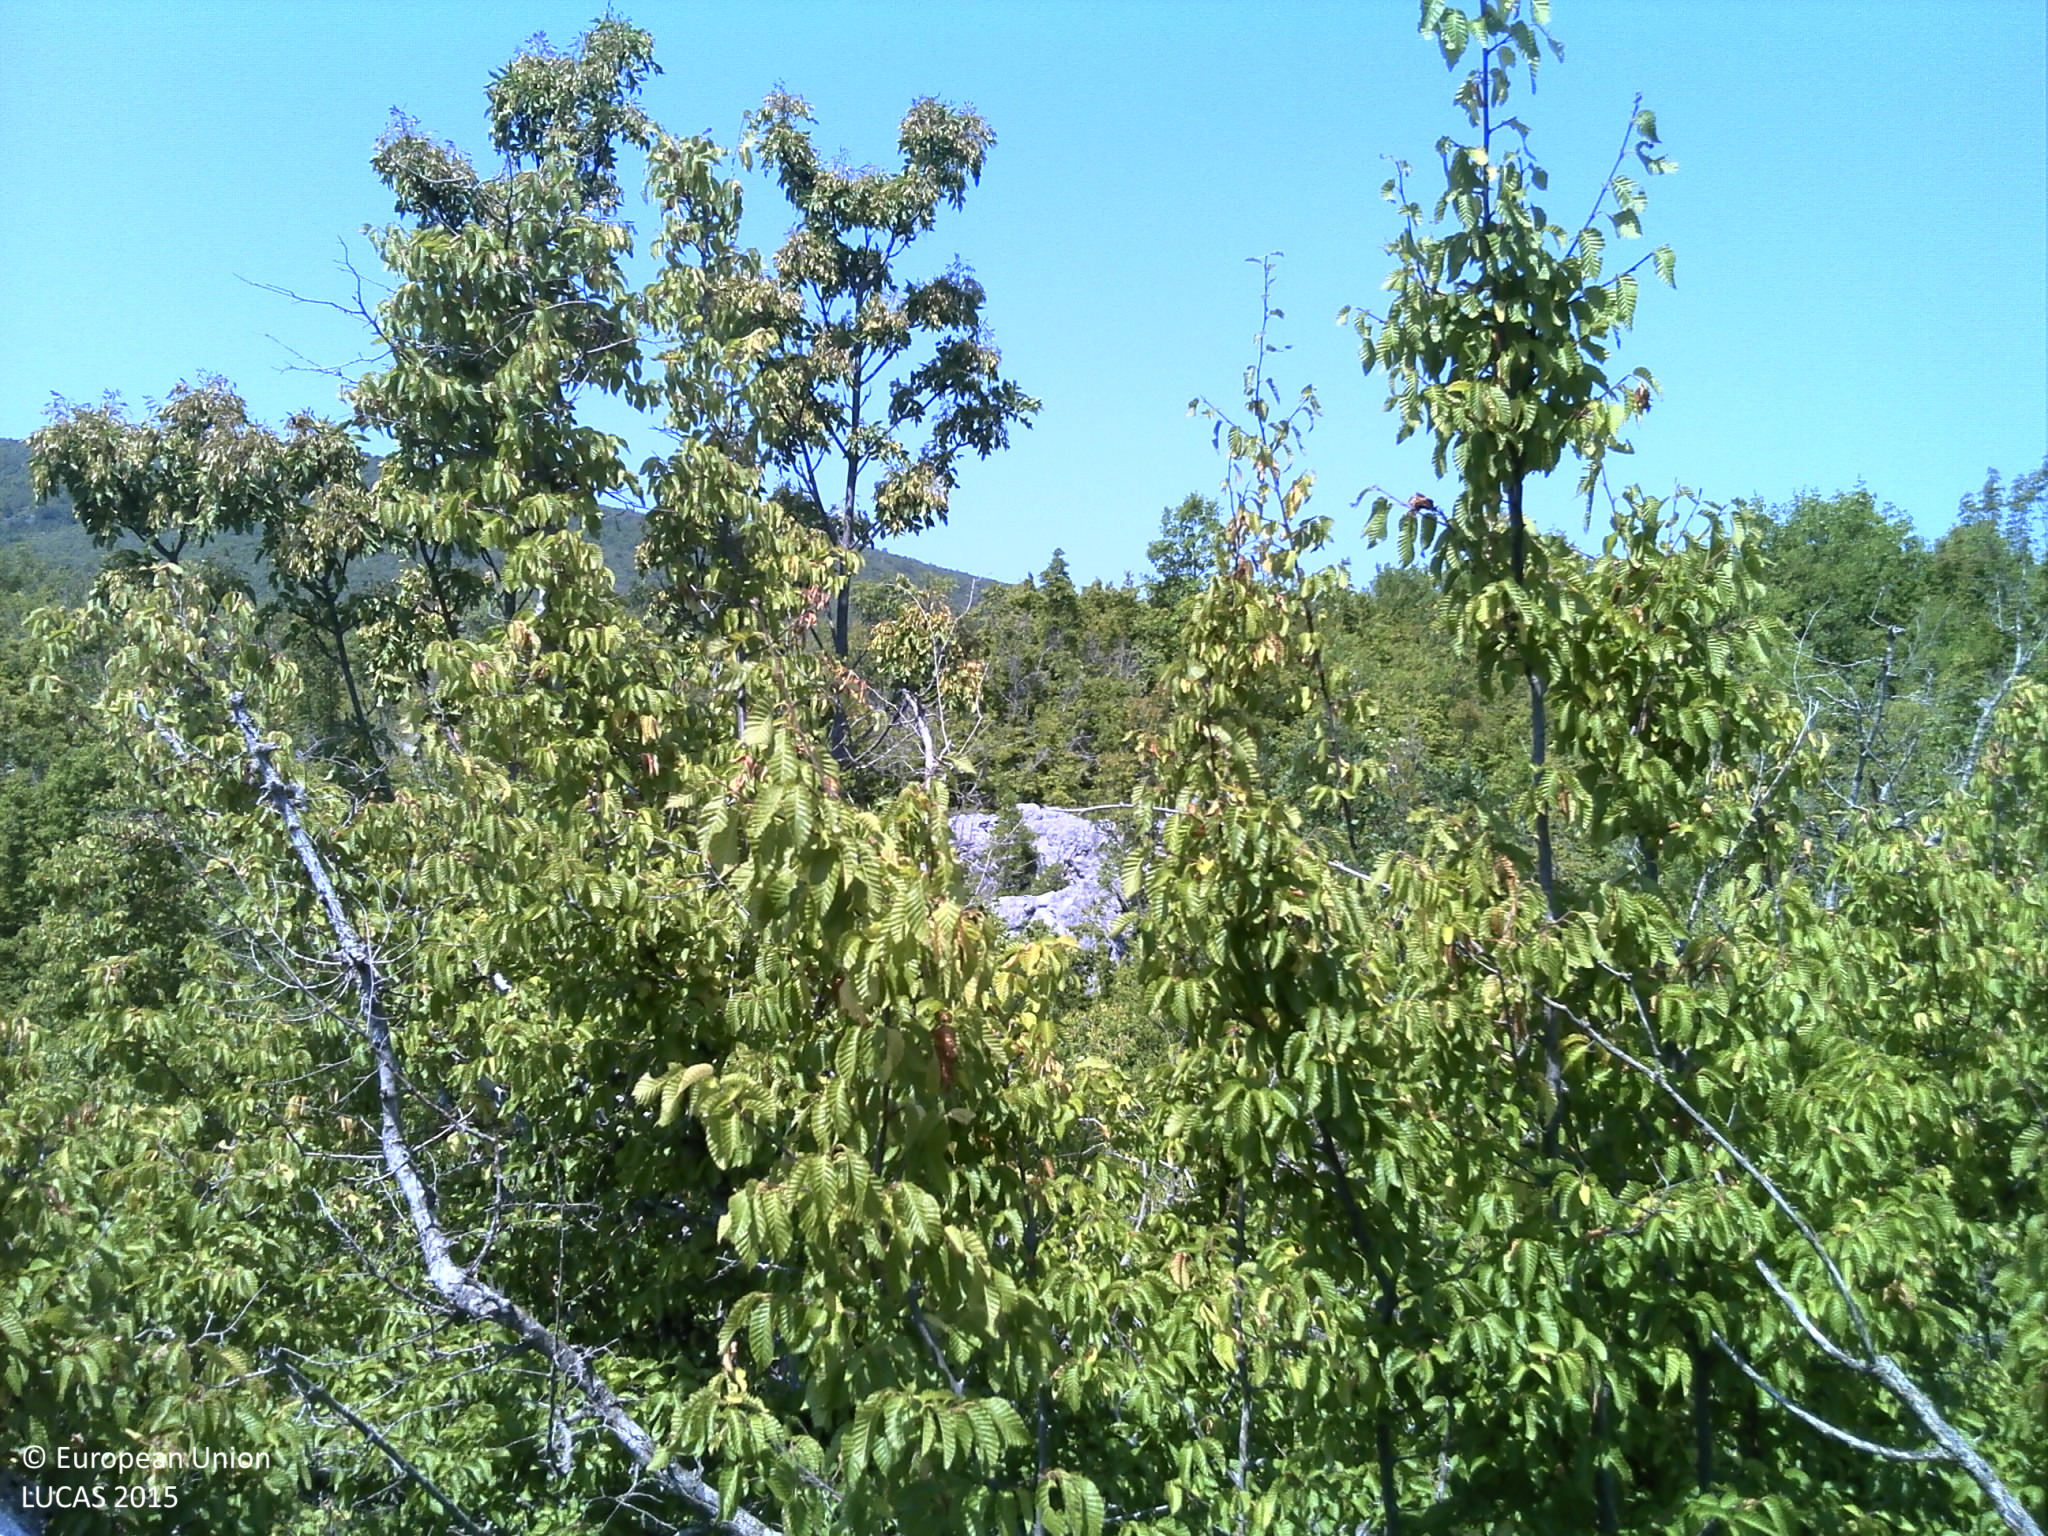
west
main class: Shrubland
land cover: Shrubland with sparse tree cover
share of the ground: > 75 %
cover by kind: shrubs 75 %, consolidated bare surface 10 %, broadleaved forest trees 5 %, herbaceous plants 5 %, unconsolidated bare surface 5 %
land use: Semi-natural and natural areas not in use
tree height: > 5 m
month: July
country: HR
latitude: 43.4624
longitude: 16.9995
